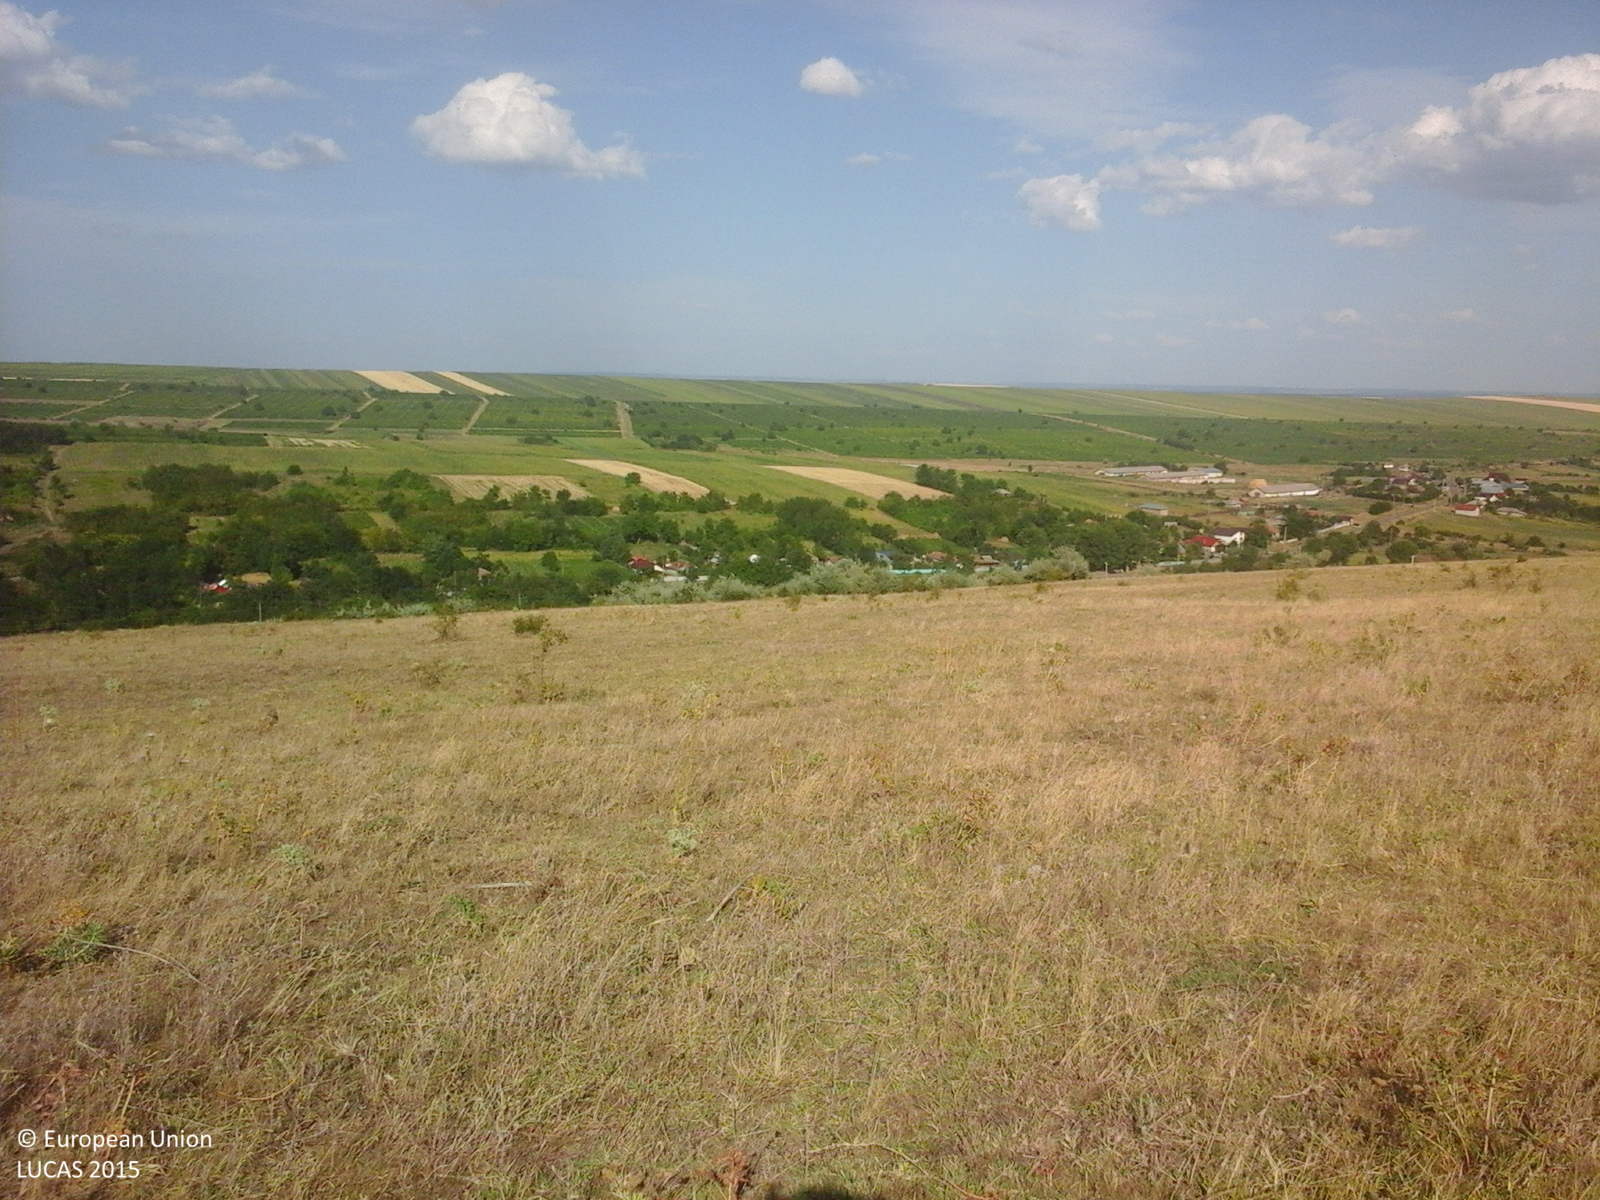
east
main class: Grassland
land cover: Spontaneously vegetated surfaces
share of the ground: > 75 %
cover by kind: herbaceous plants 100 %
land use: Fallow land
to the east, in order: Spontaneously vegetated surfaces; Tracks; Spontaneously vegetated surfaces; Shrubland with sparse tree cover
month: August
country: RO
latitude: 46.2789
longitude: 27.9144
